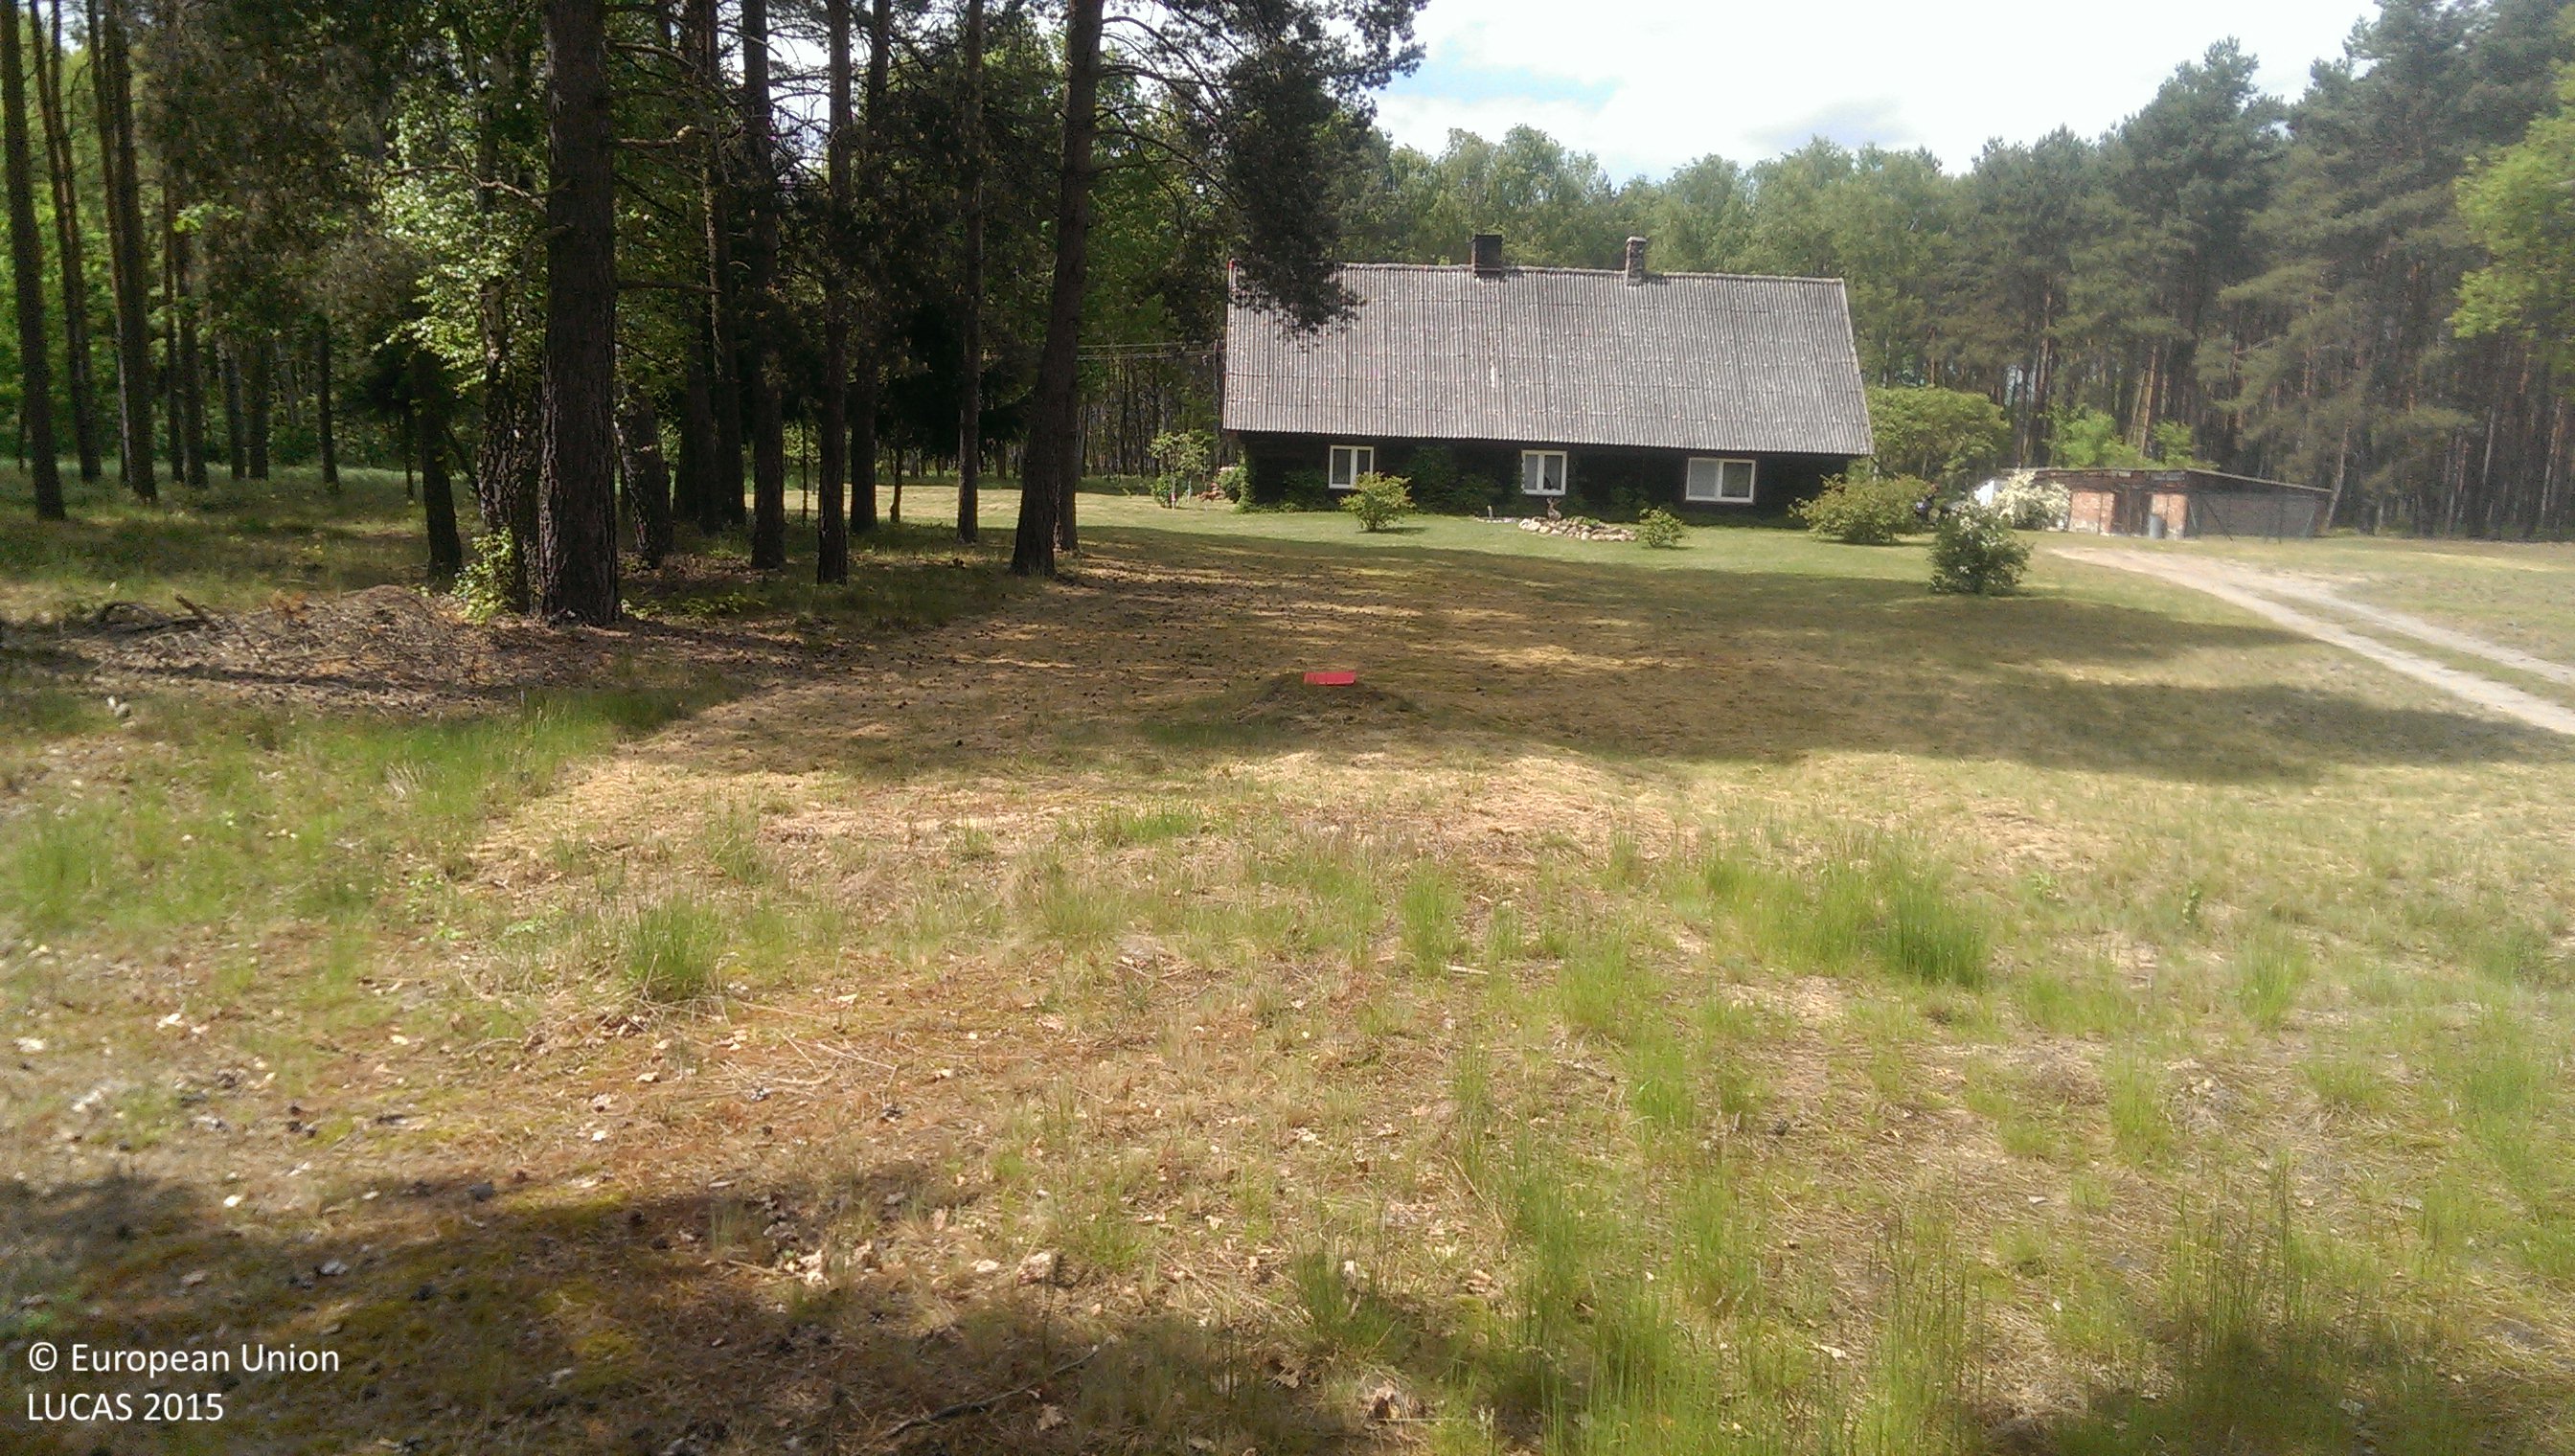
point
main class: Grassland
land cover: Grassland without tree/shrub cover
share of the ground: > 75 %
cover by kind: herbaceous plants 85 %, unconsolidated bare surface 15 %
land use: Residential
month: May
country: PL
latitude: 52.2335
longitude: 16.2001
